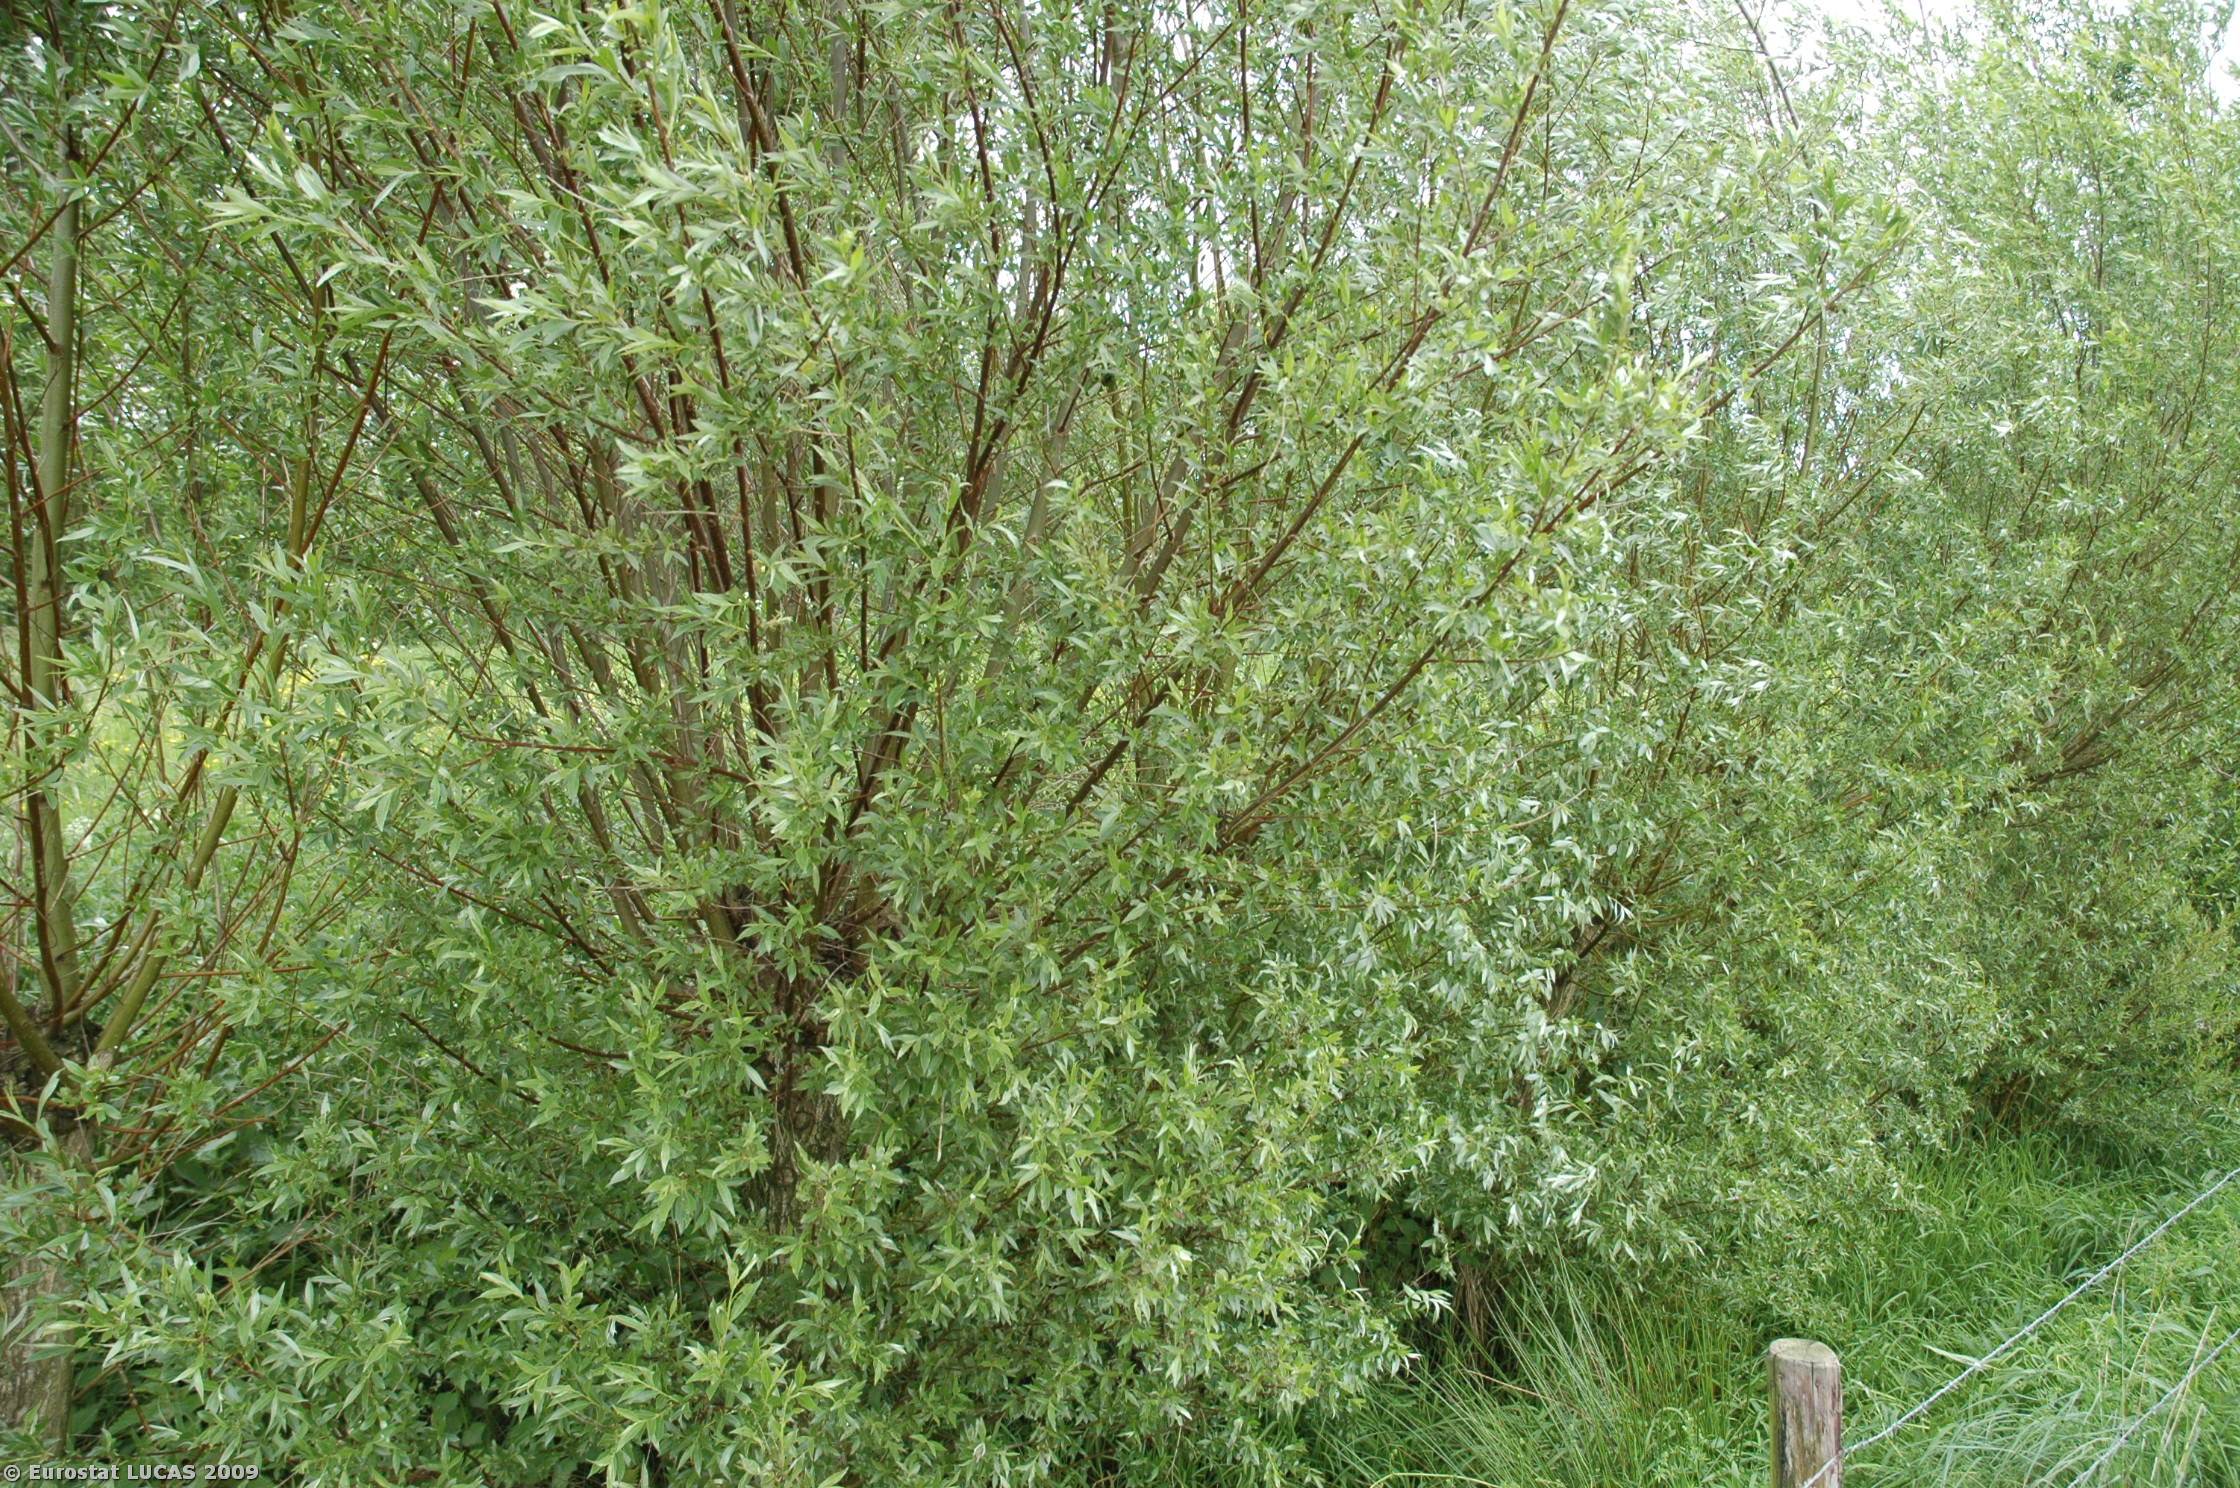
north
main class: Grassland
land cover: Grassland without tree/shrub cover
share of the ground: > 75 %
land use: Unused
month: May
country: NL
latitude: 51.9984
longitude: 5.3517
